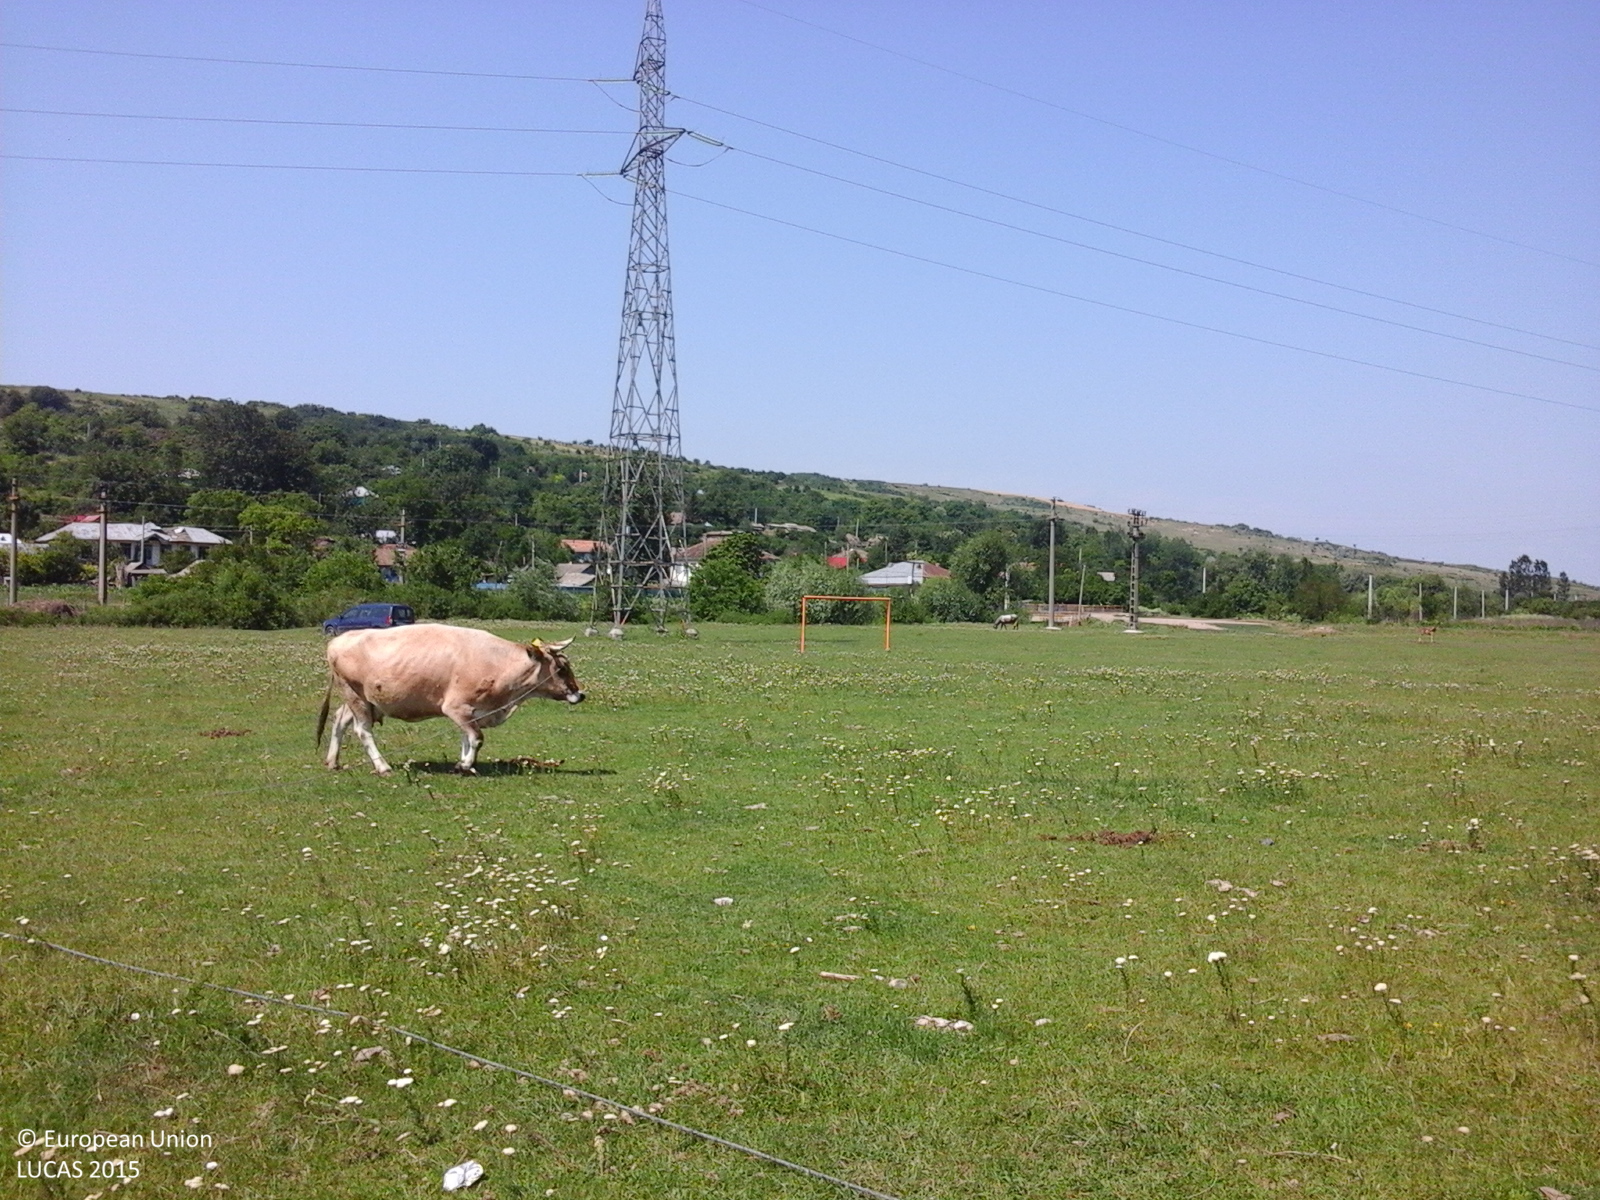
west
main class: Grassland
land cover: Grassland without tree/shrub cover
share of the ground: > 75 %
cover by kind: herbaceous plants 100 %
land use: Agriculture (excluding fallow land and kitchen gardens)
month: June
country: RO
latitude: 46.7345
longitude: 27.5047
